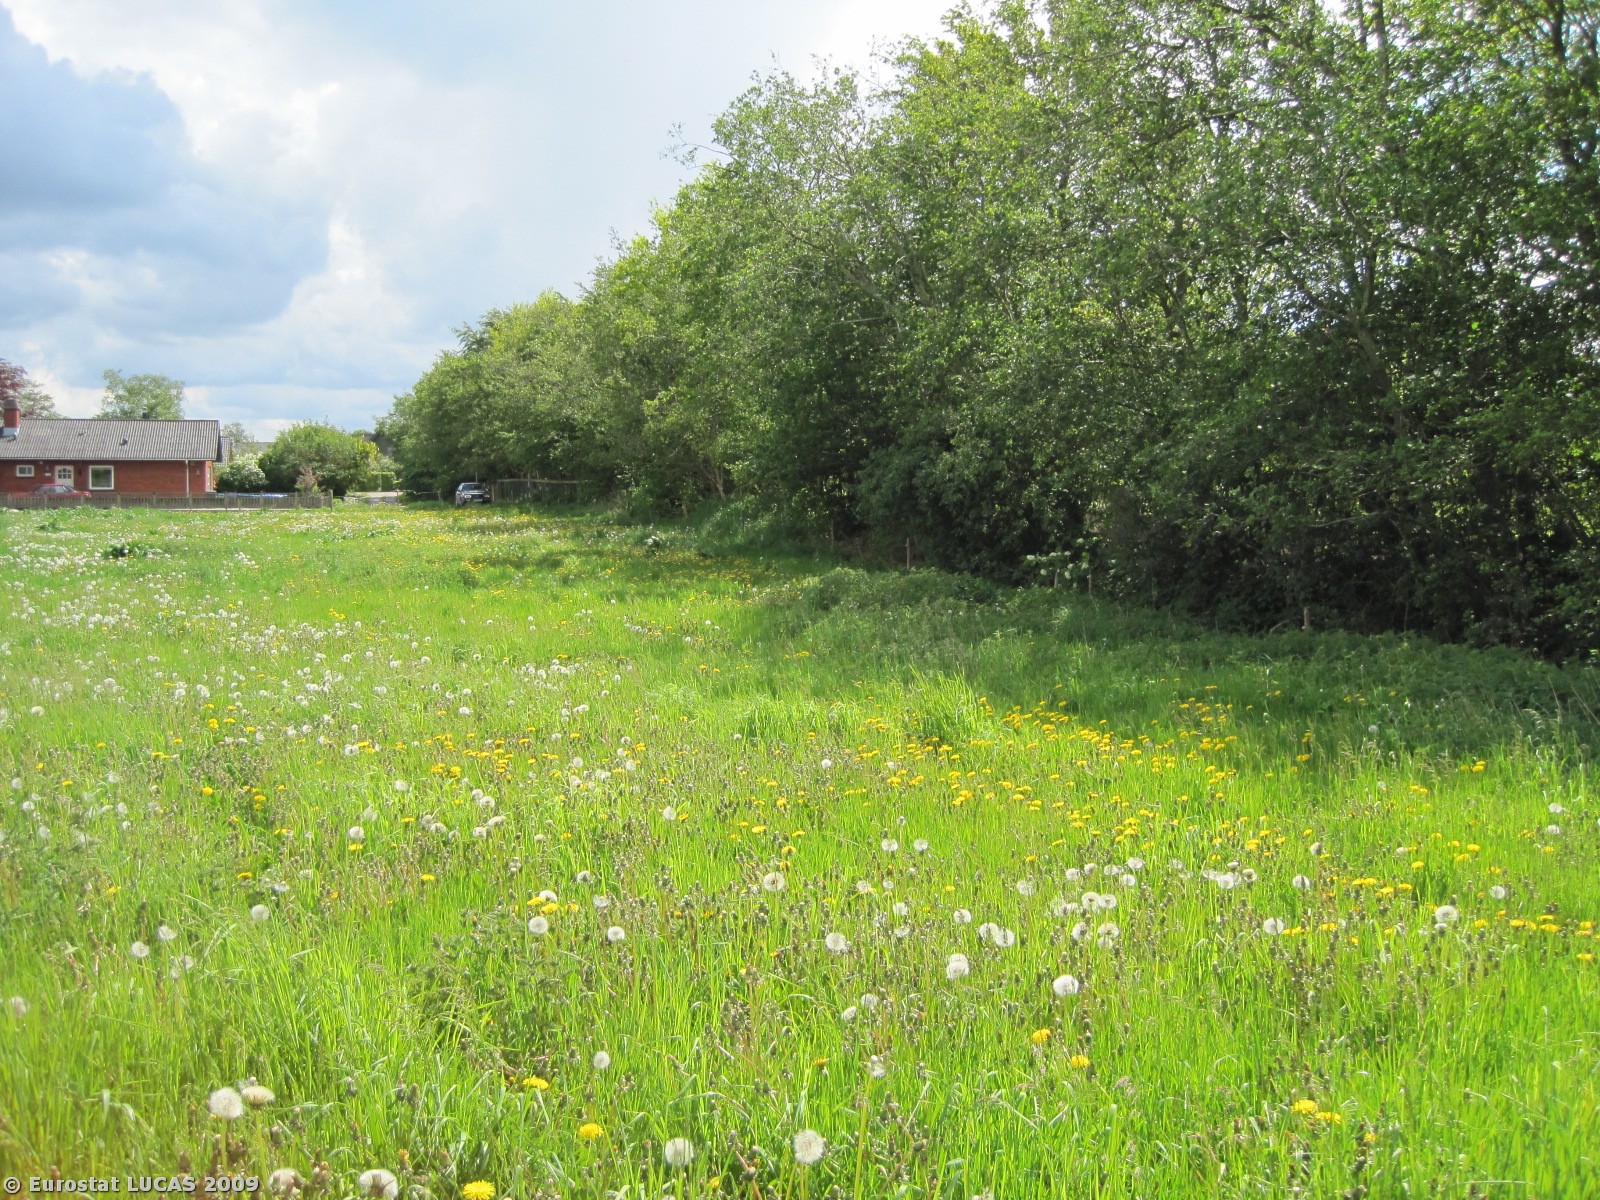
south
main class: Grassland
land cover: Grassland without tree/shrub cover
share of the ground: > 75 %
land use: Agriculture (excluding fallow land and kitchen gardens)
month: May
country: DK
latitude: 56.7269
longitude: 9.8205
